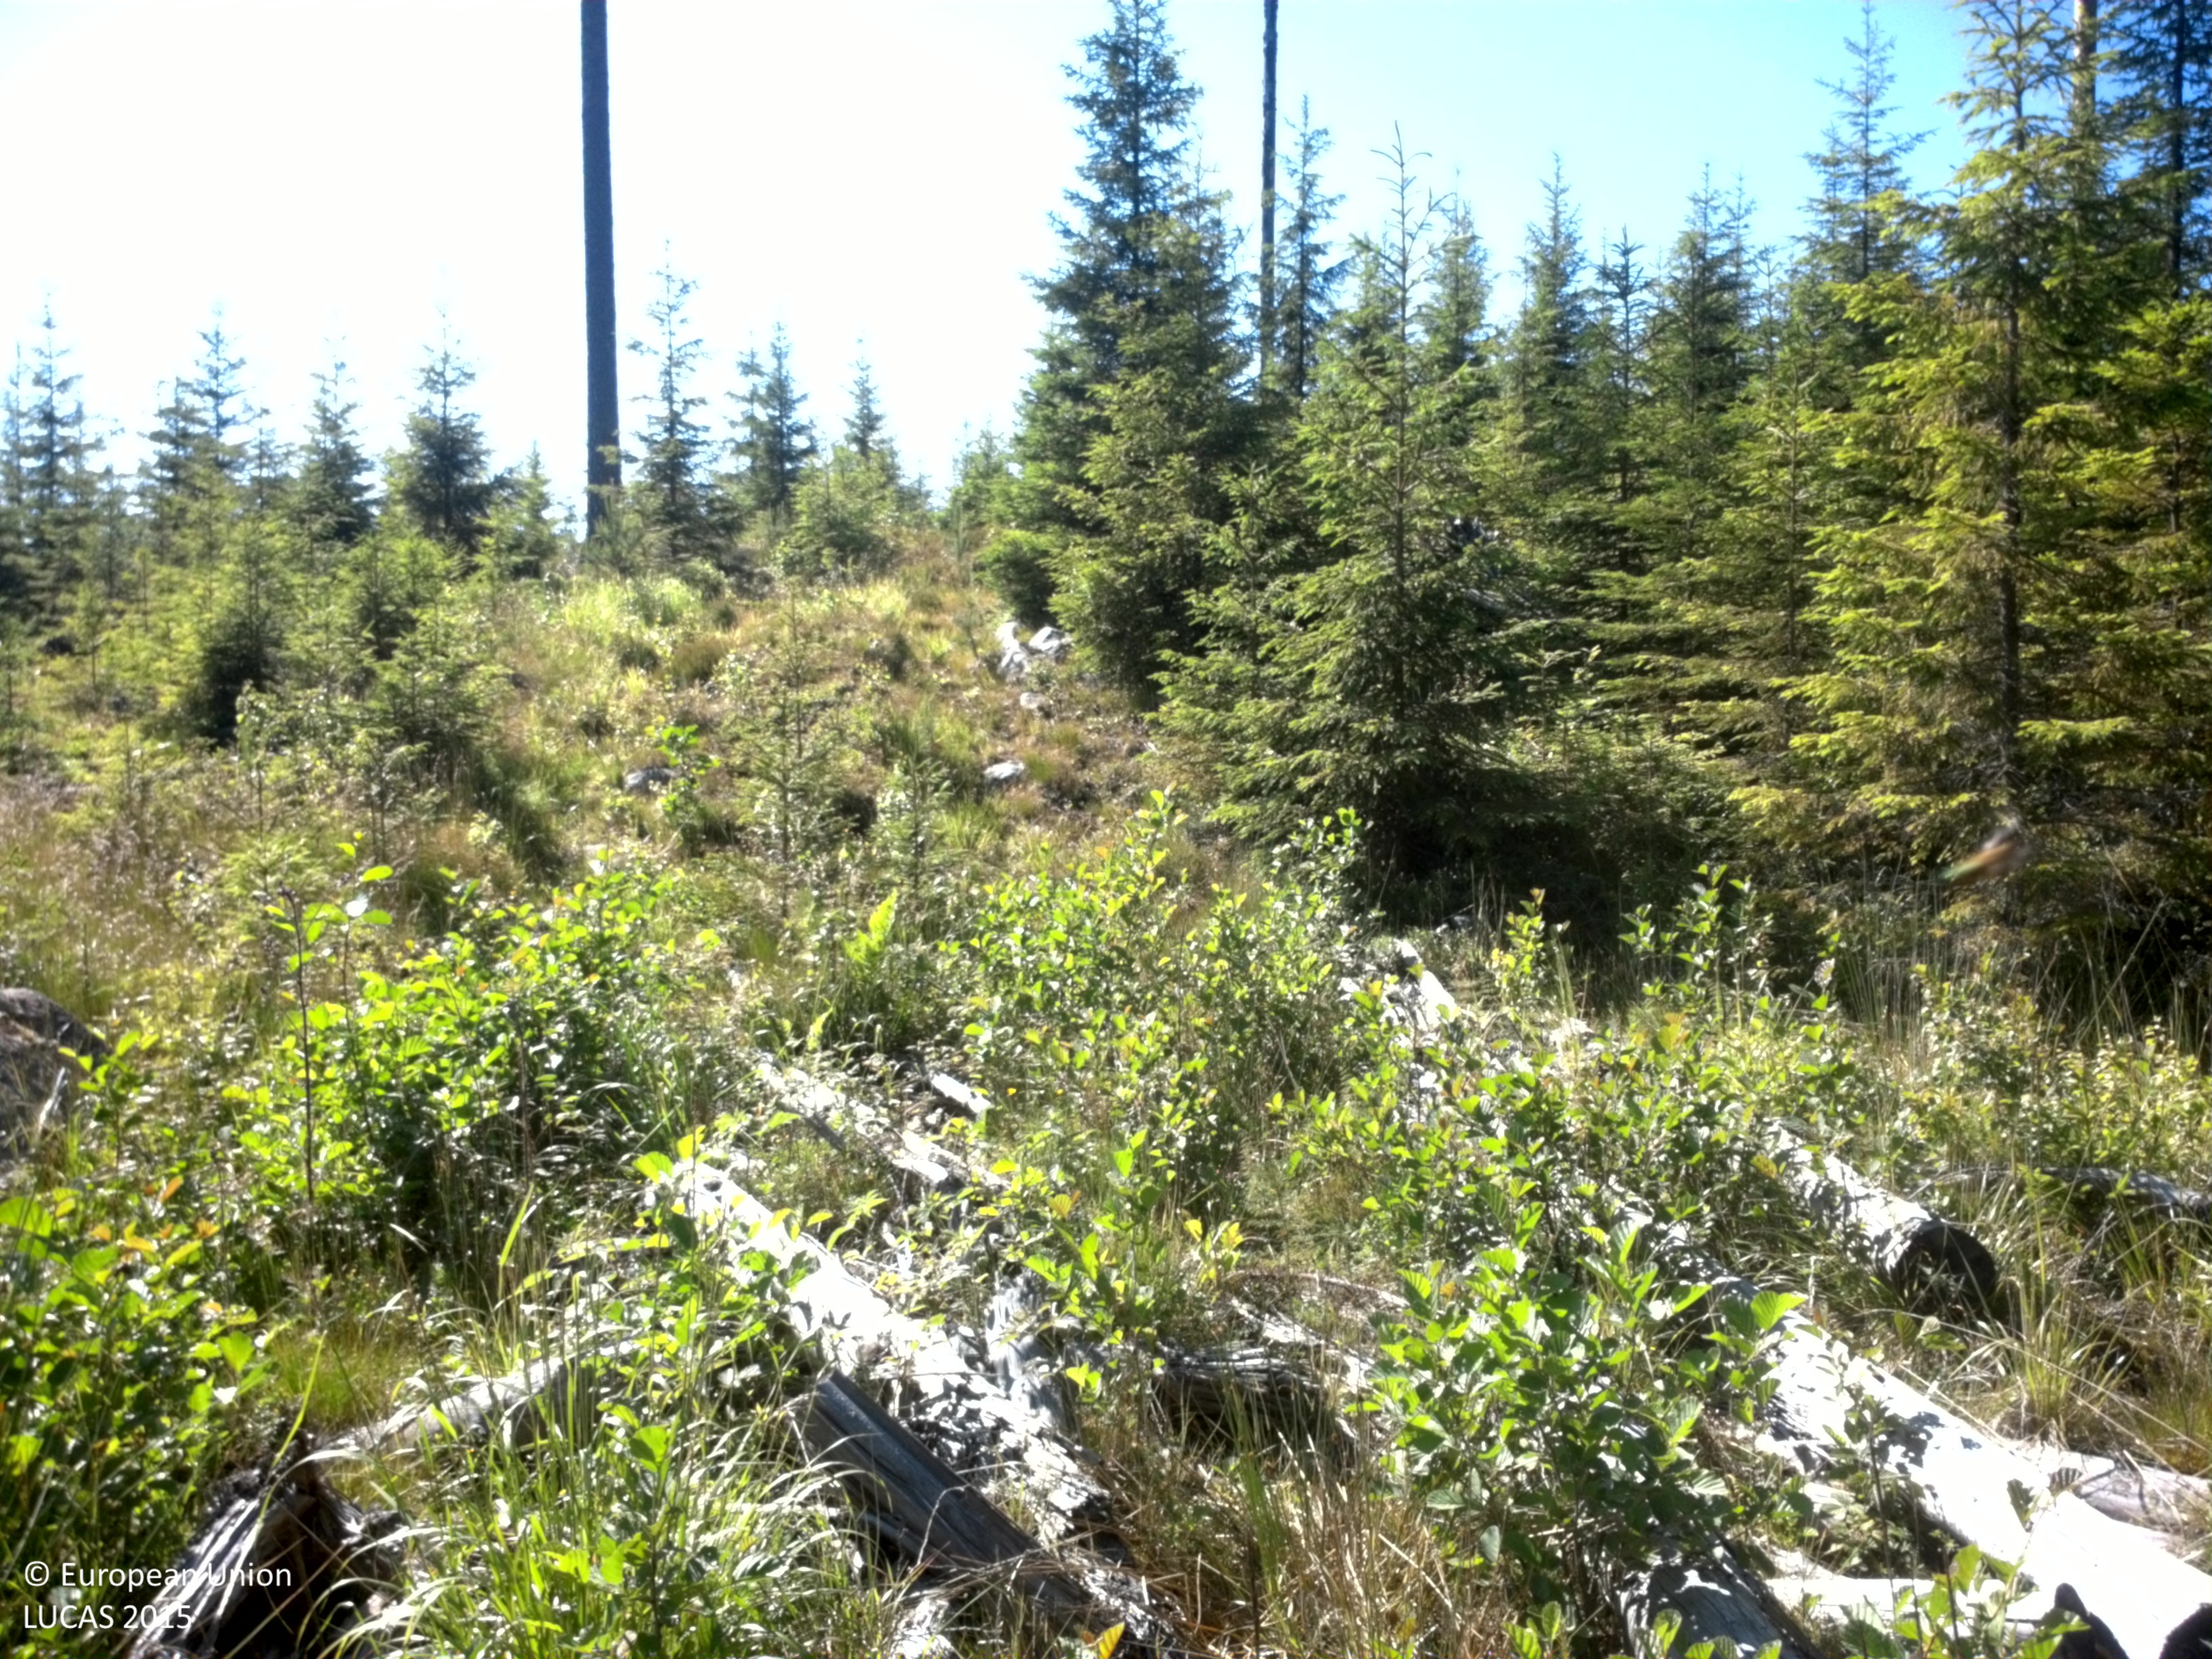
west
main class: Woodland
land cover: Spruce dominated mixed woodland
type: boreal forest
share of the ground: 25 - 50 %
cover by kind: herbaceous plants 30 %, coniferous forest trees 25 %, shrubs 25 %, broadleaved forest trees 20 %
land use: Forestry
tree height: < 5 m
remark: Clear cut
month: July
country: SE
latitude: 59.8231
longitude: 12.0808
